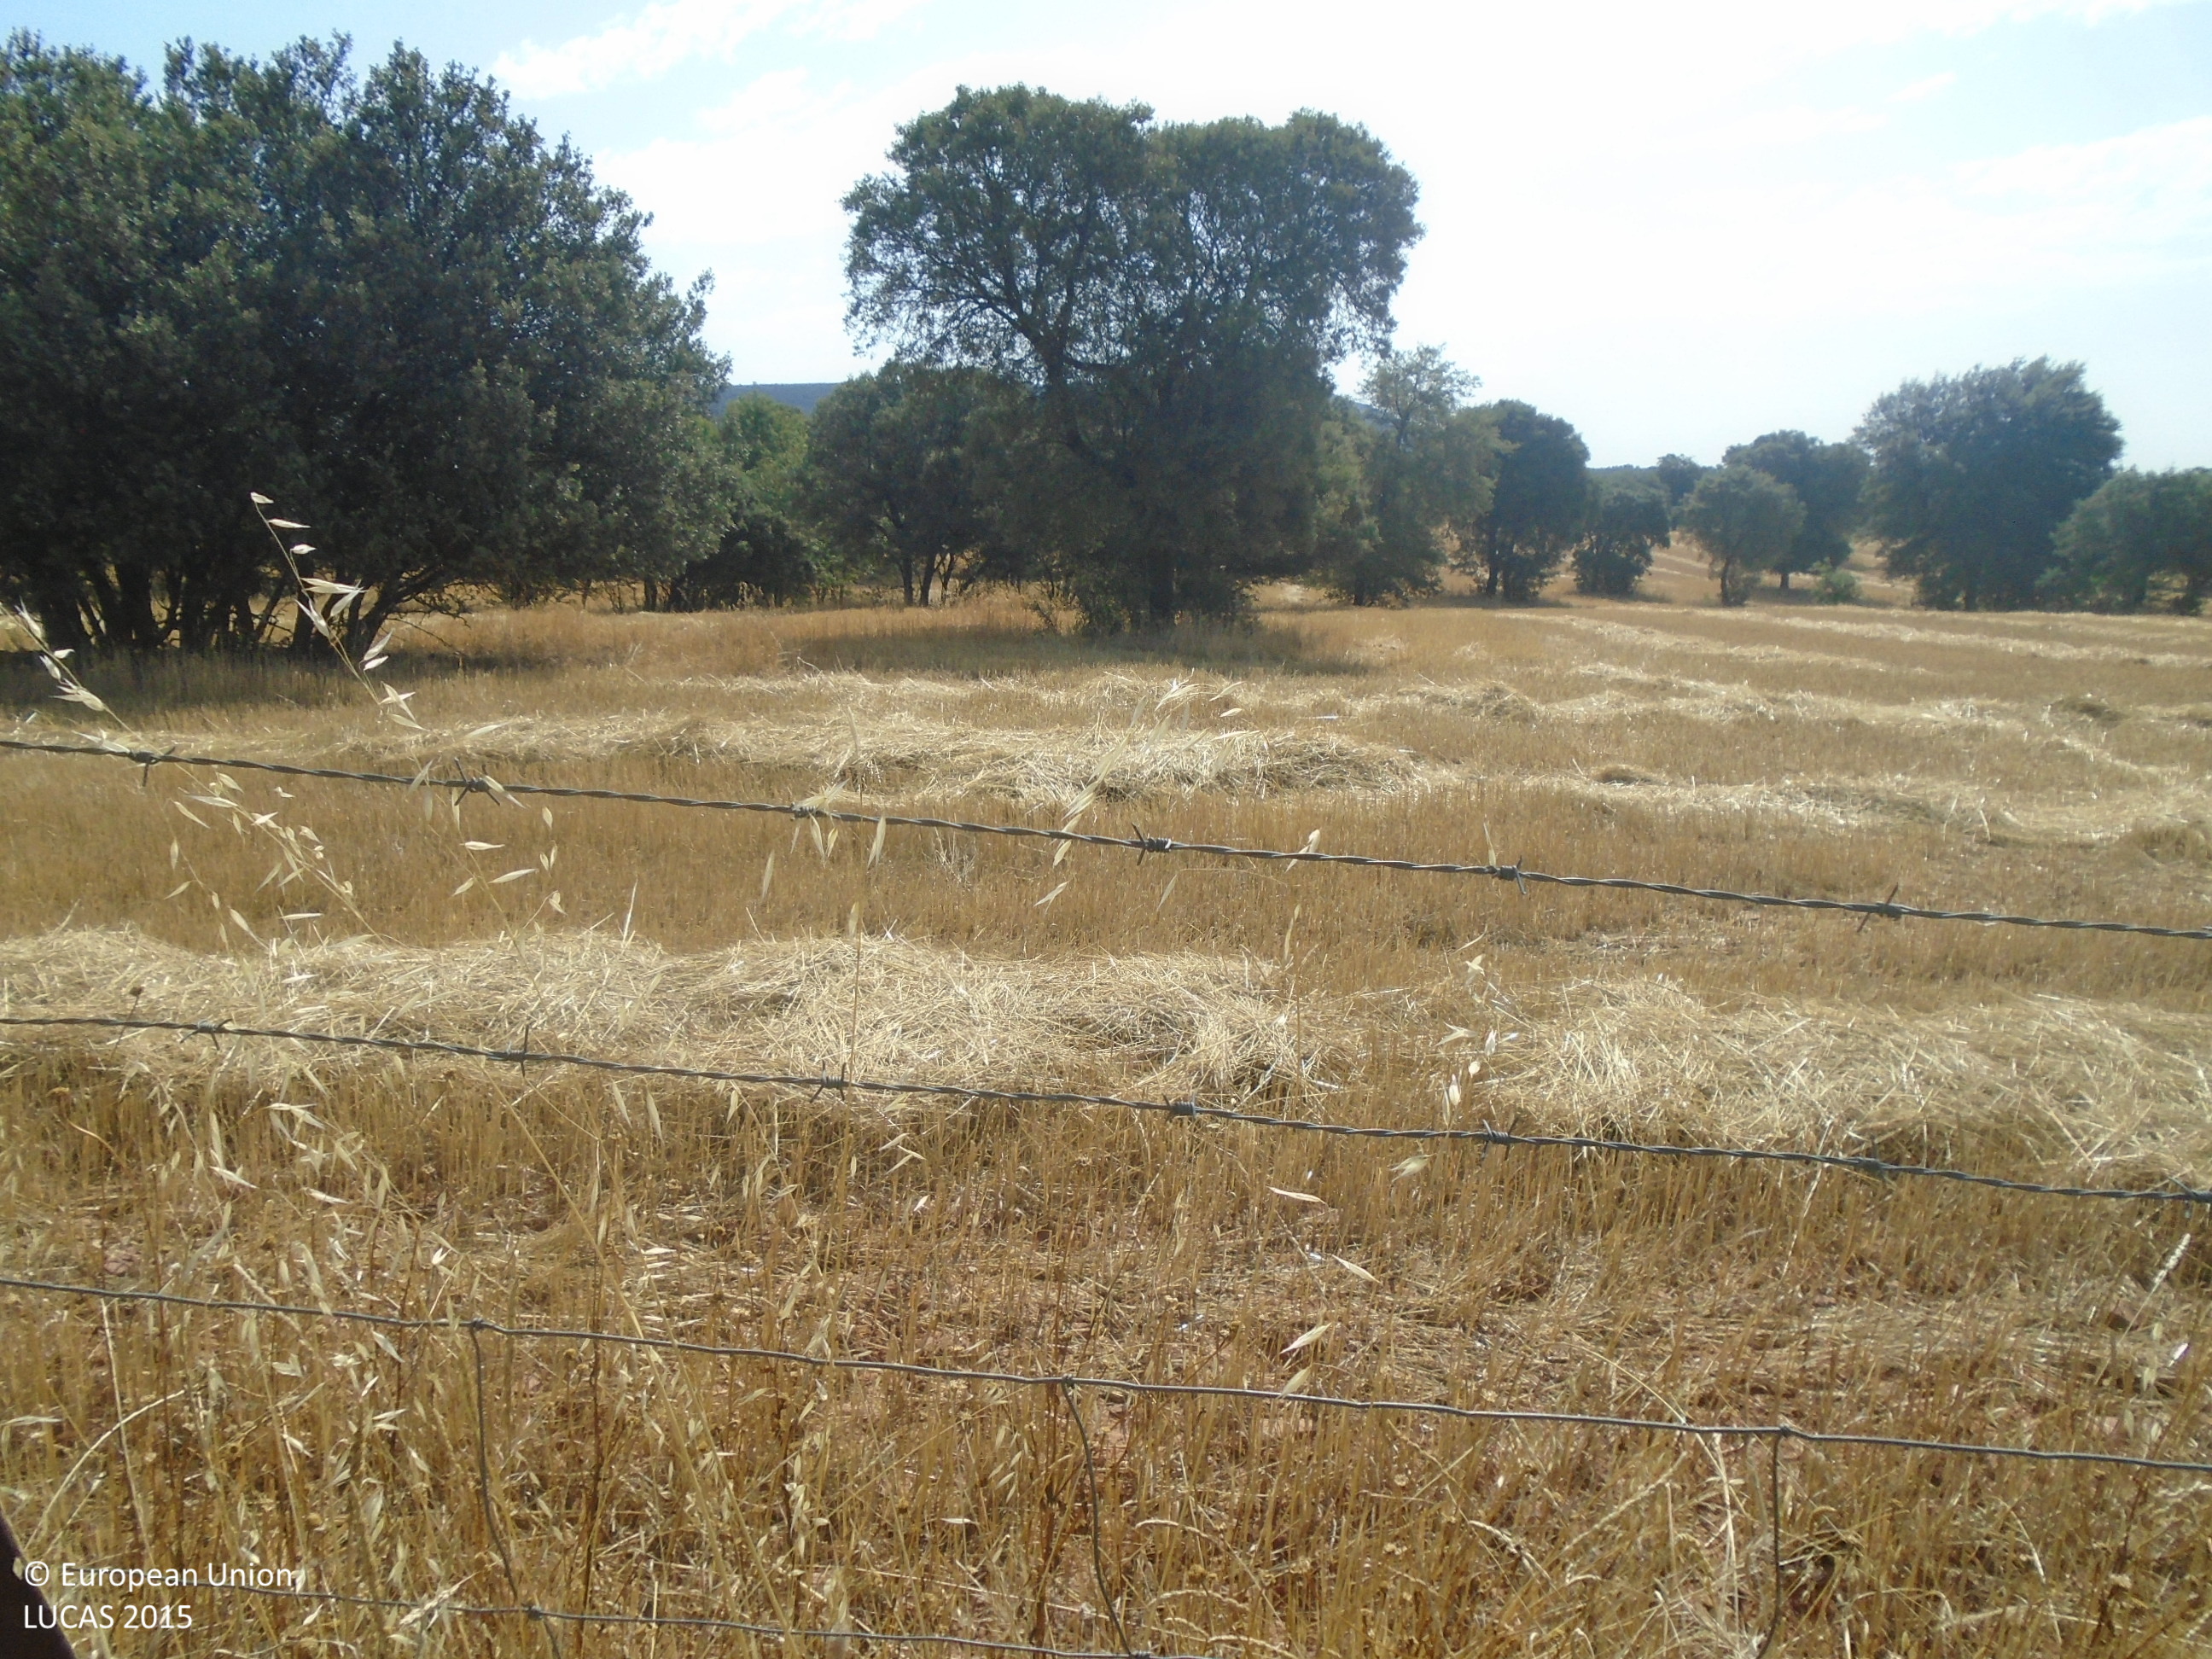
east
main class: Woodland
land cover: Broadleaved woodland
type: broadleaved evergreen forest
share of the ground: 10 - 25 %
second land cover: Oats
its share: > 75 %
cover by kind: broadleaved forest trees 15 %
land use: Forestry
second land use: Agriculture (excluding fallow land and kitchen gardens)
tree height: > 5 m
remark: Harvested field
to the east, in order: Broadleaved woodland; Oats
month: July
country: ES
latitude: 39.3095
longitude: -4.5184
